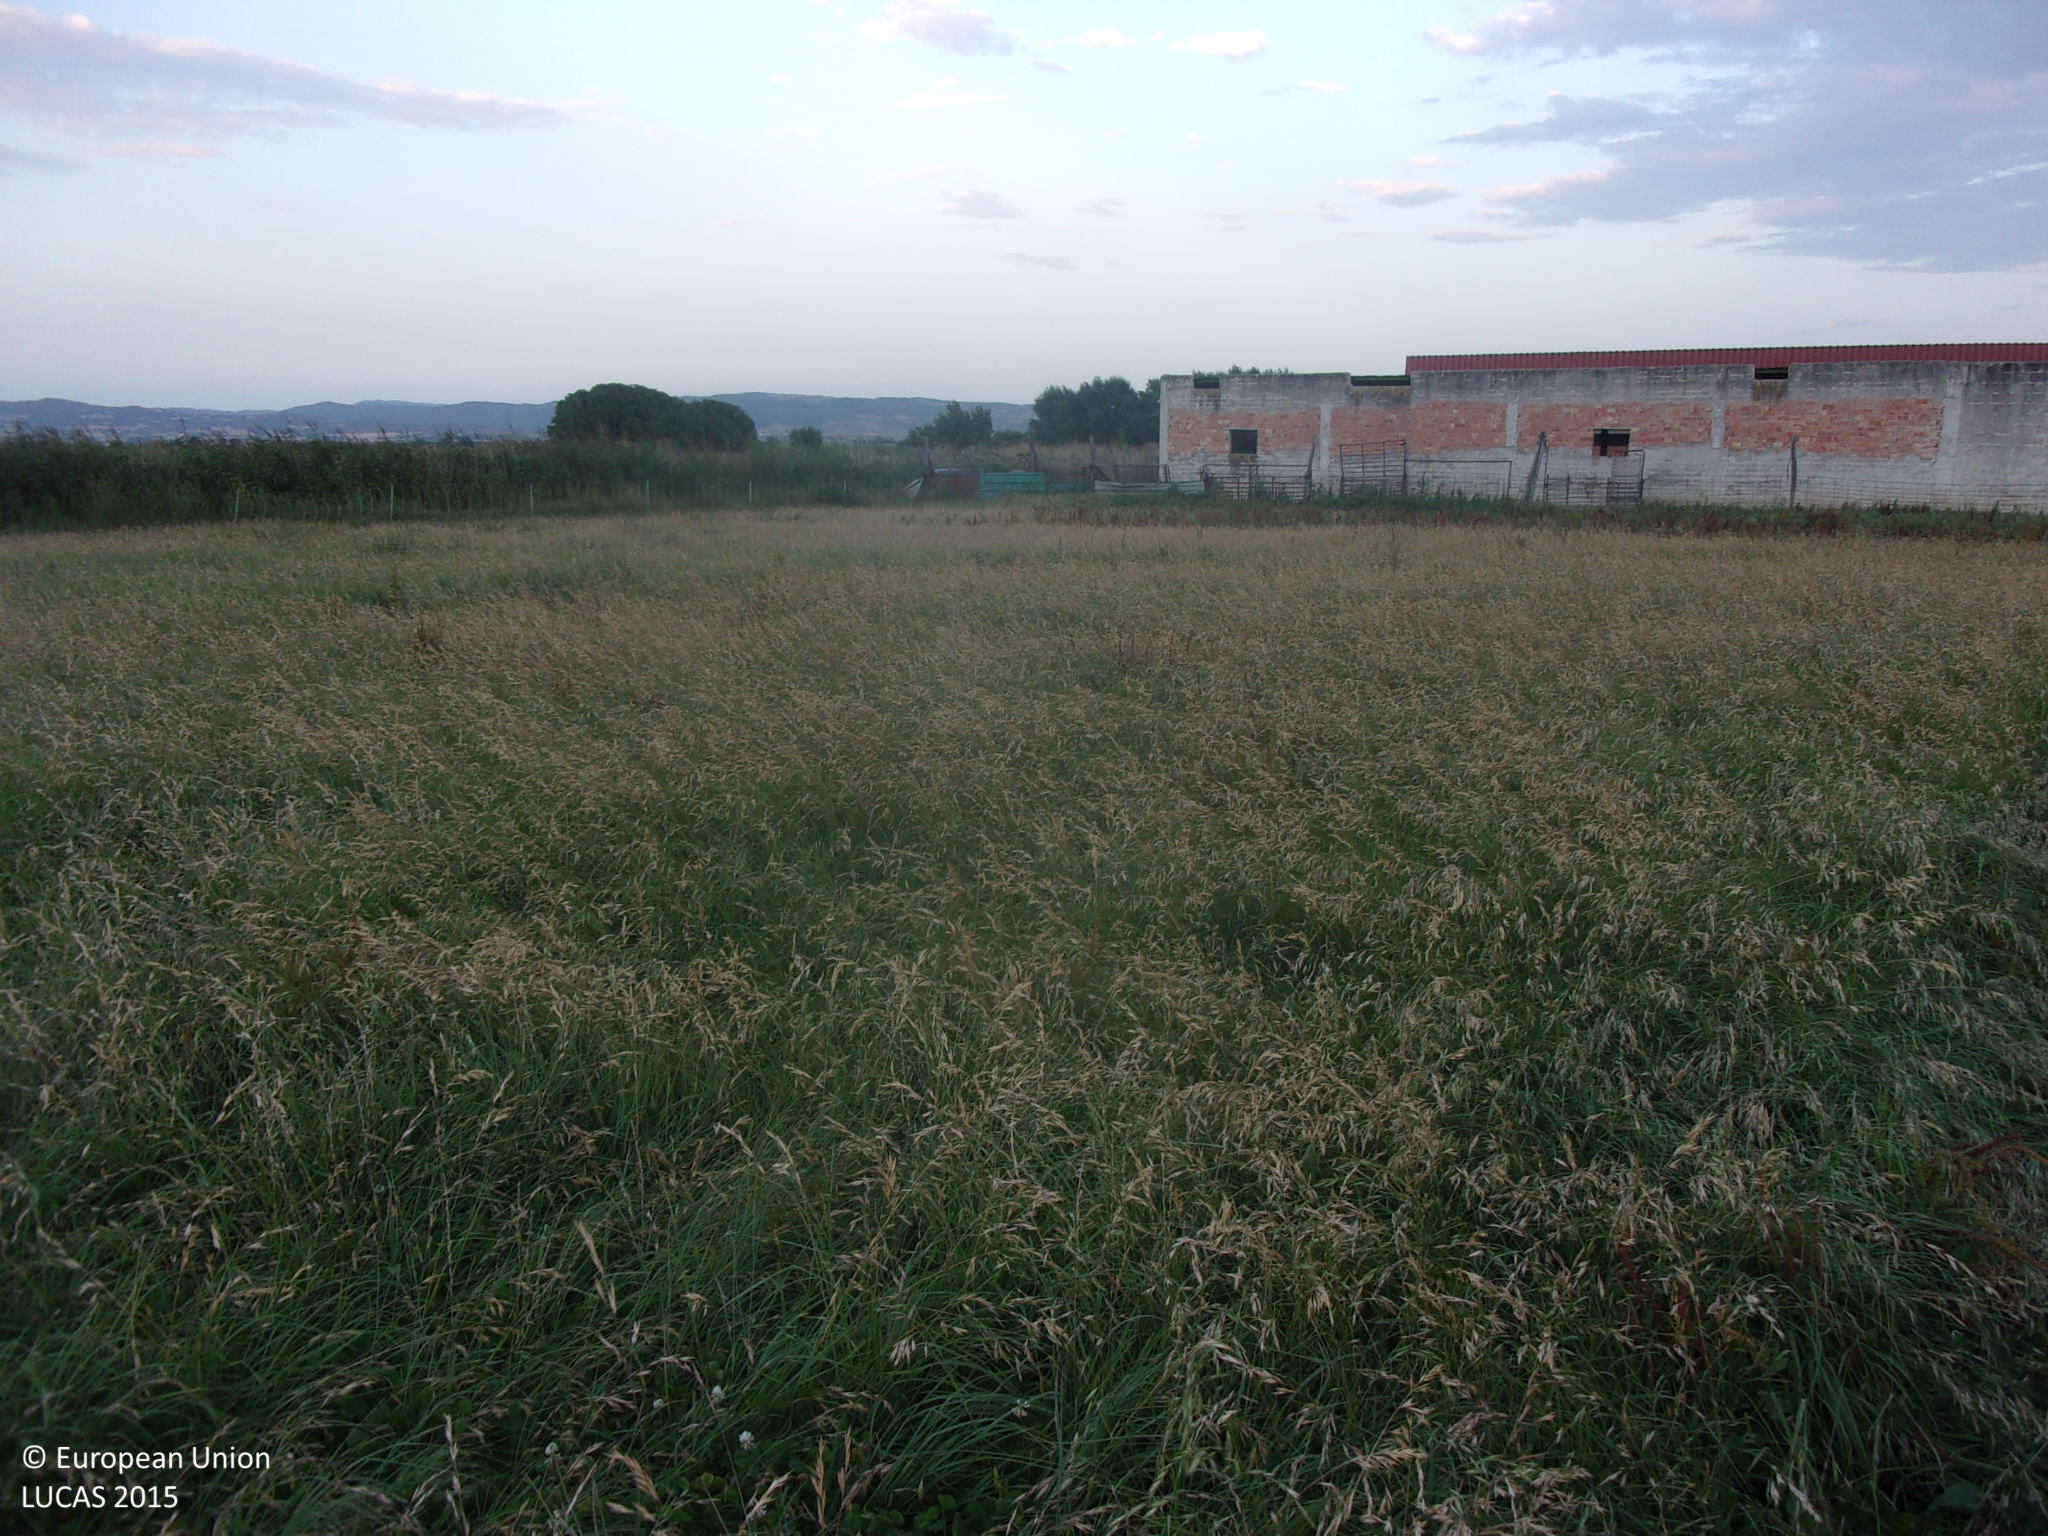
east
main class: Cropland
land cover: Temporary grasslands
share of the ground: > 75 %
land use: Agriculture (excluding fallow land and kitchen gardens)
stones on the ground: < 10 %
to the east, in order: Temporary grasslands; Artificial constructions in urban areas; Grass margins; Ditches and canals; Grass margins; Temporary grasslands; Grass margins; Electric lines; Ditches and canals; Grass margins; Temporary grasslands; Grass margins; Temporary grasslands; Shruby margins
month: August
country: ES
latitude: 42.3562
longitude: -1.3840
